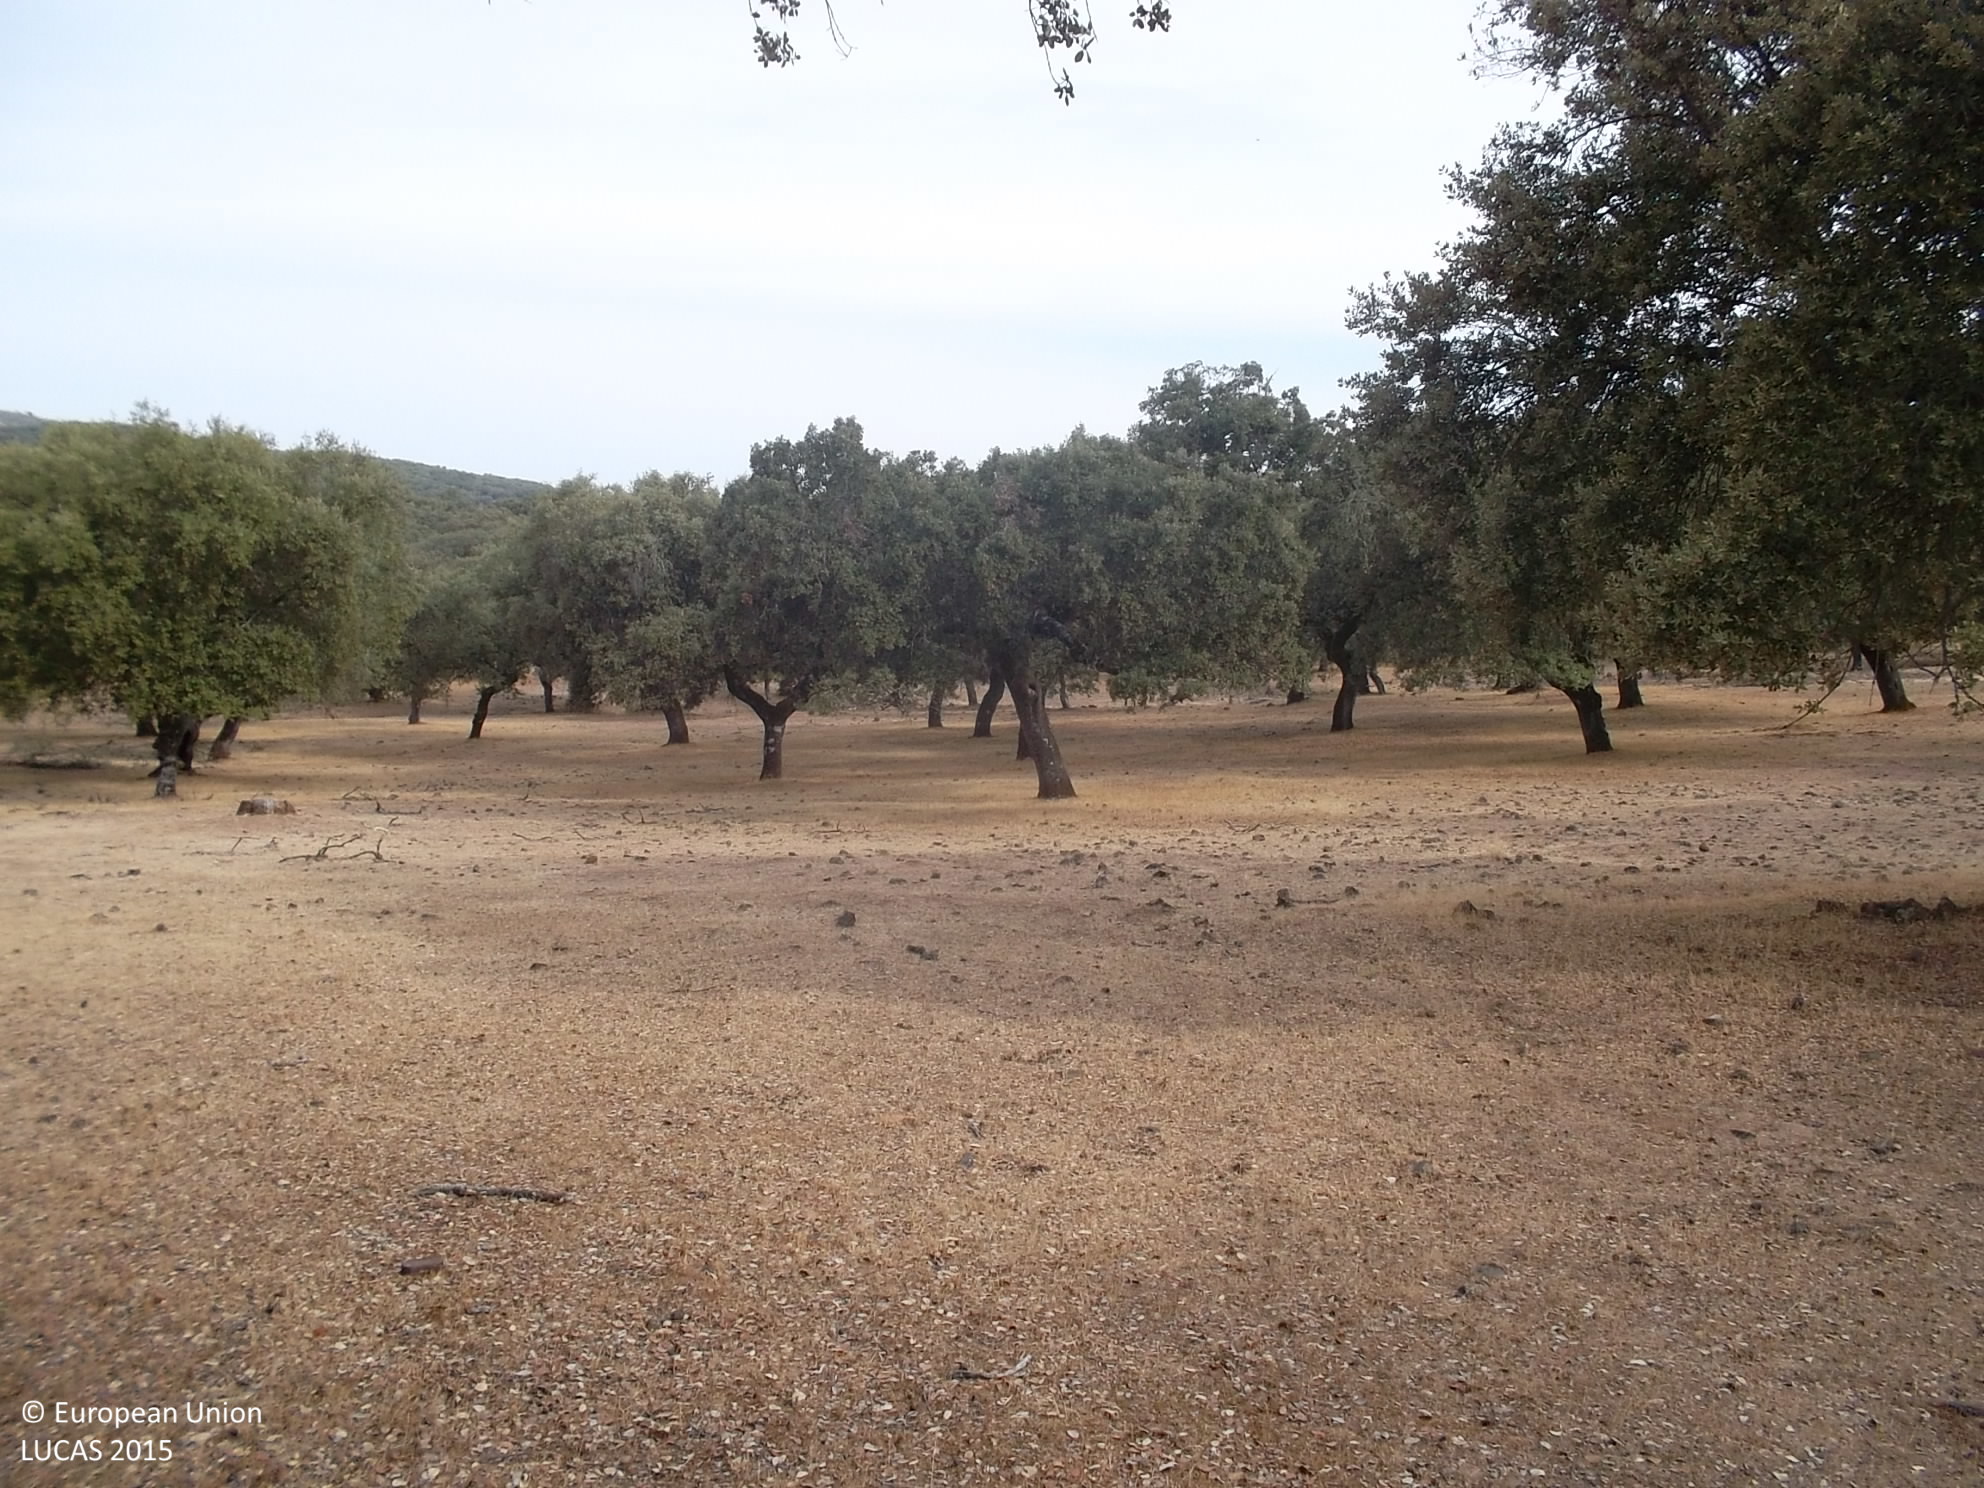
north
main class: Woodland
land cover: Broadleaved woodland
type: broadleaved evergreen forest
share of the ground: 25 - 50 %
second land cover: Grassland without tree/shrub cover
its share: 50 - 75 %
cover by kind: herbaceous plants 55 %, broadleaved forest trees 45 %
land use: Forestry
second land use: Agriculture (excluding fallow land and kitchen gardens)
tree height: > 5 m
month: September
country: ES
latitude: 38.4780
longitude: -6.7829
